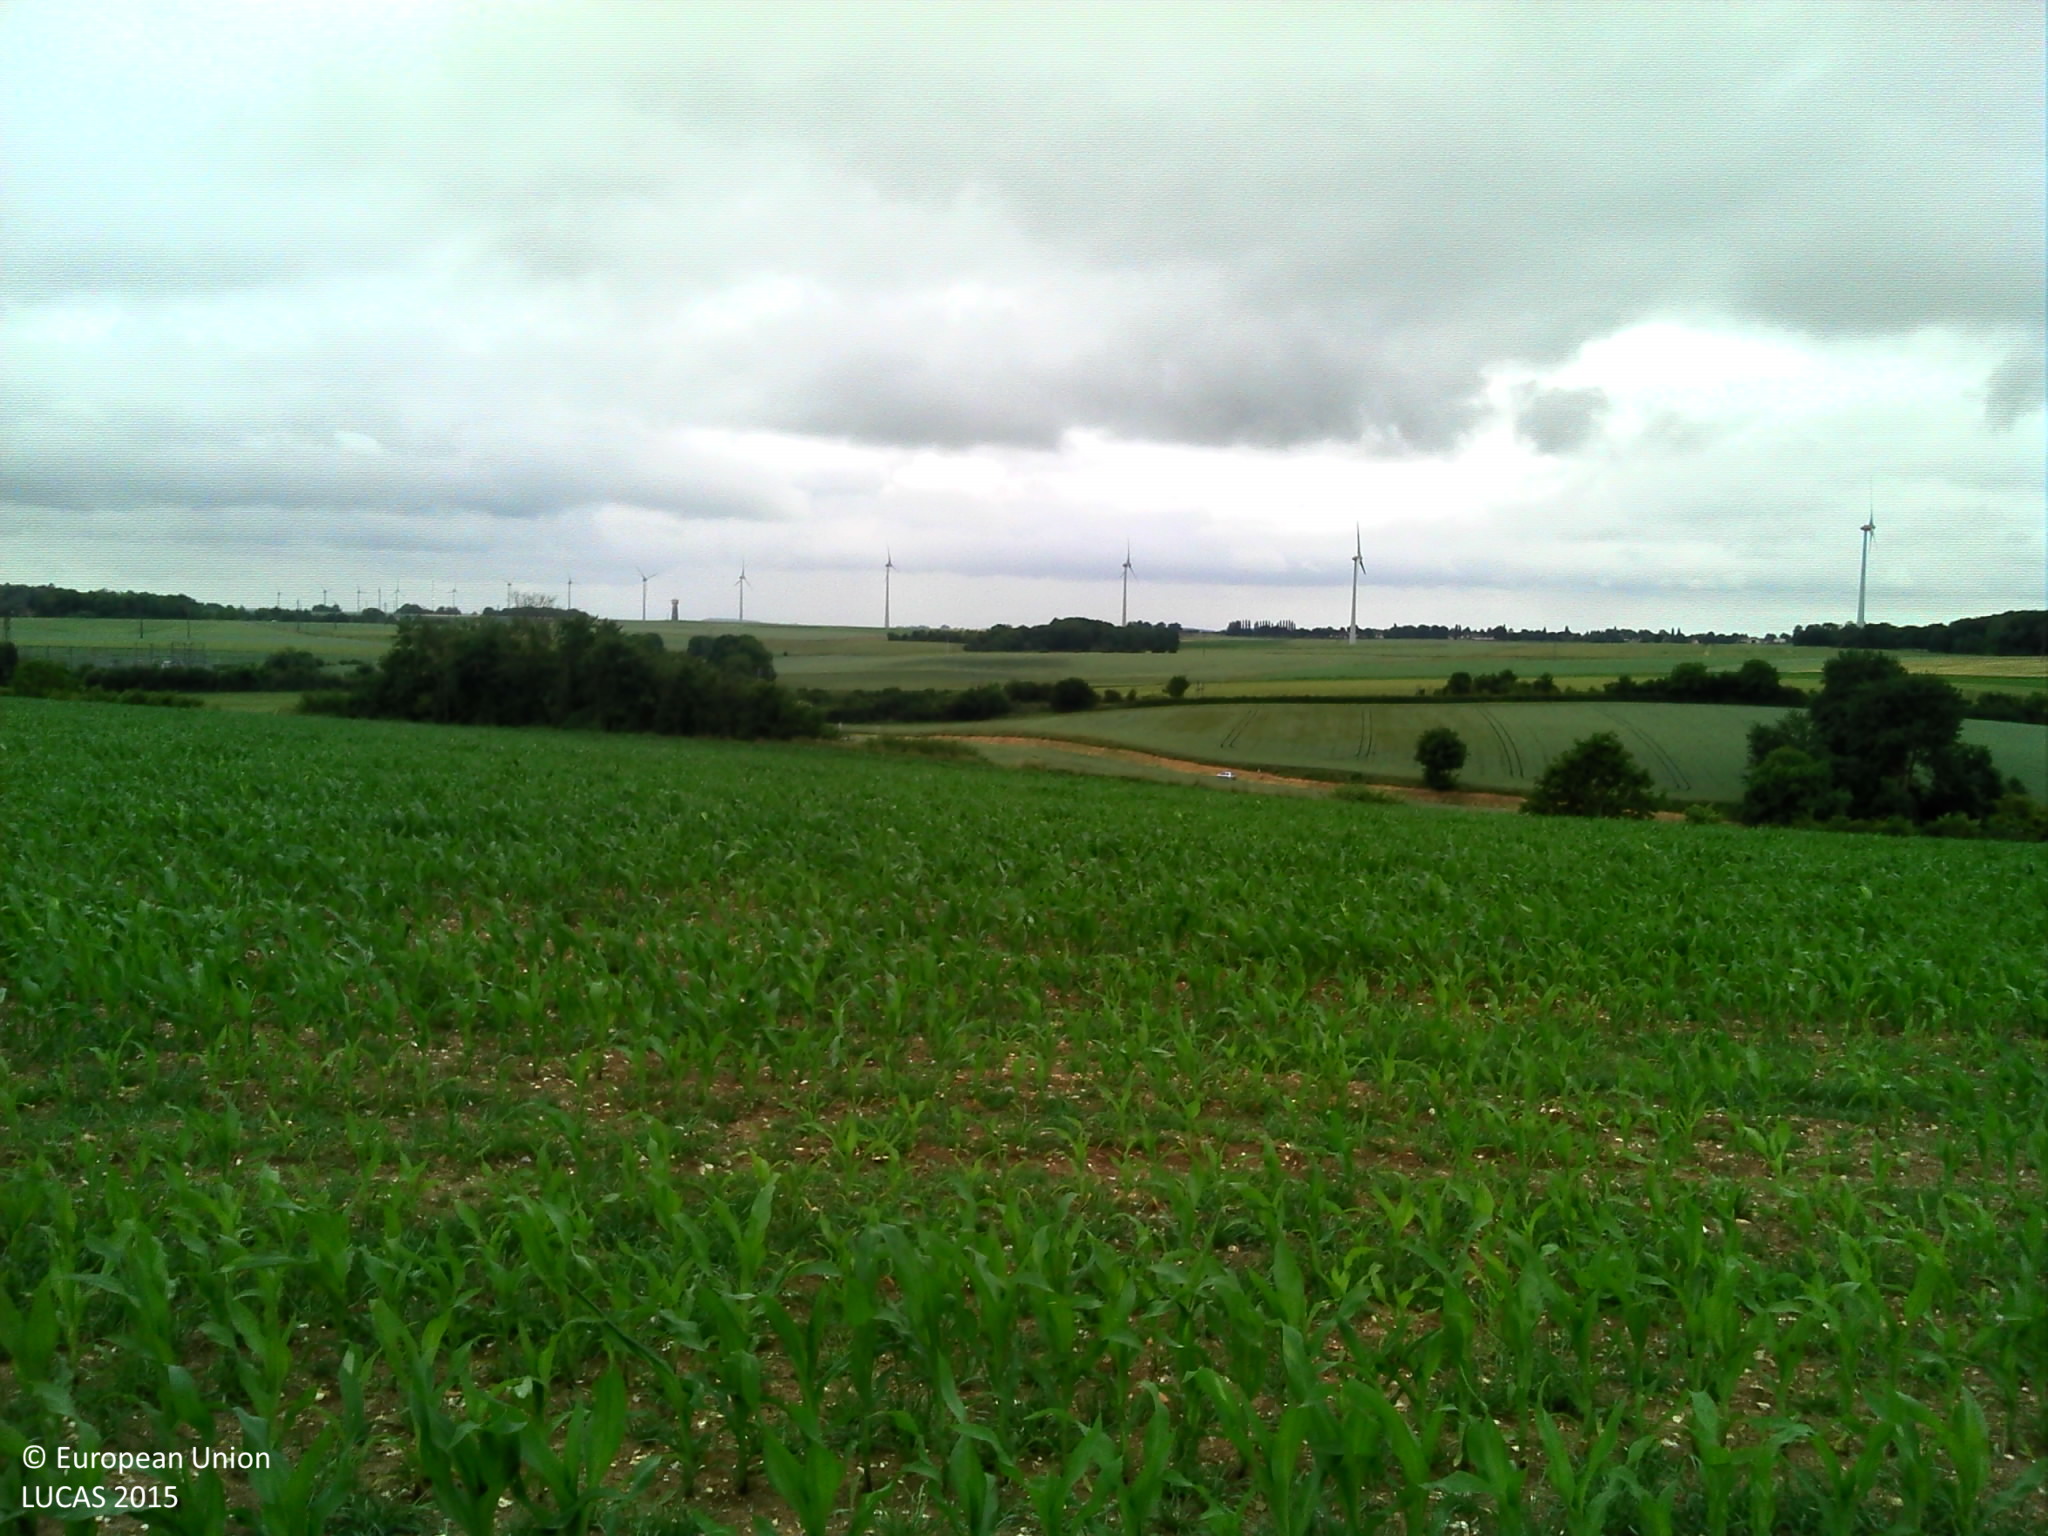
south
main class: Cropland
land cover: Maize
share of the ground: 25 - 50 %
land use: Agriculture (excluding fallow land and kitchen gardens)
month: June
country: FR
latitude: 49.5886
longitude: 2.4208
